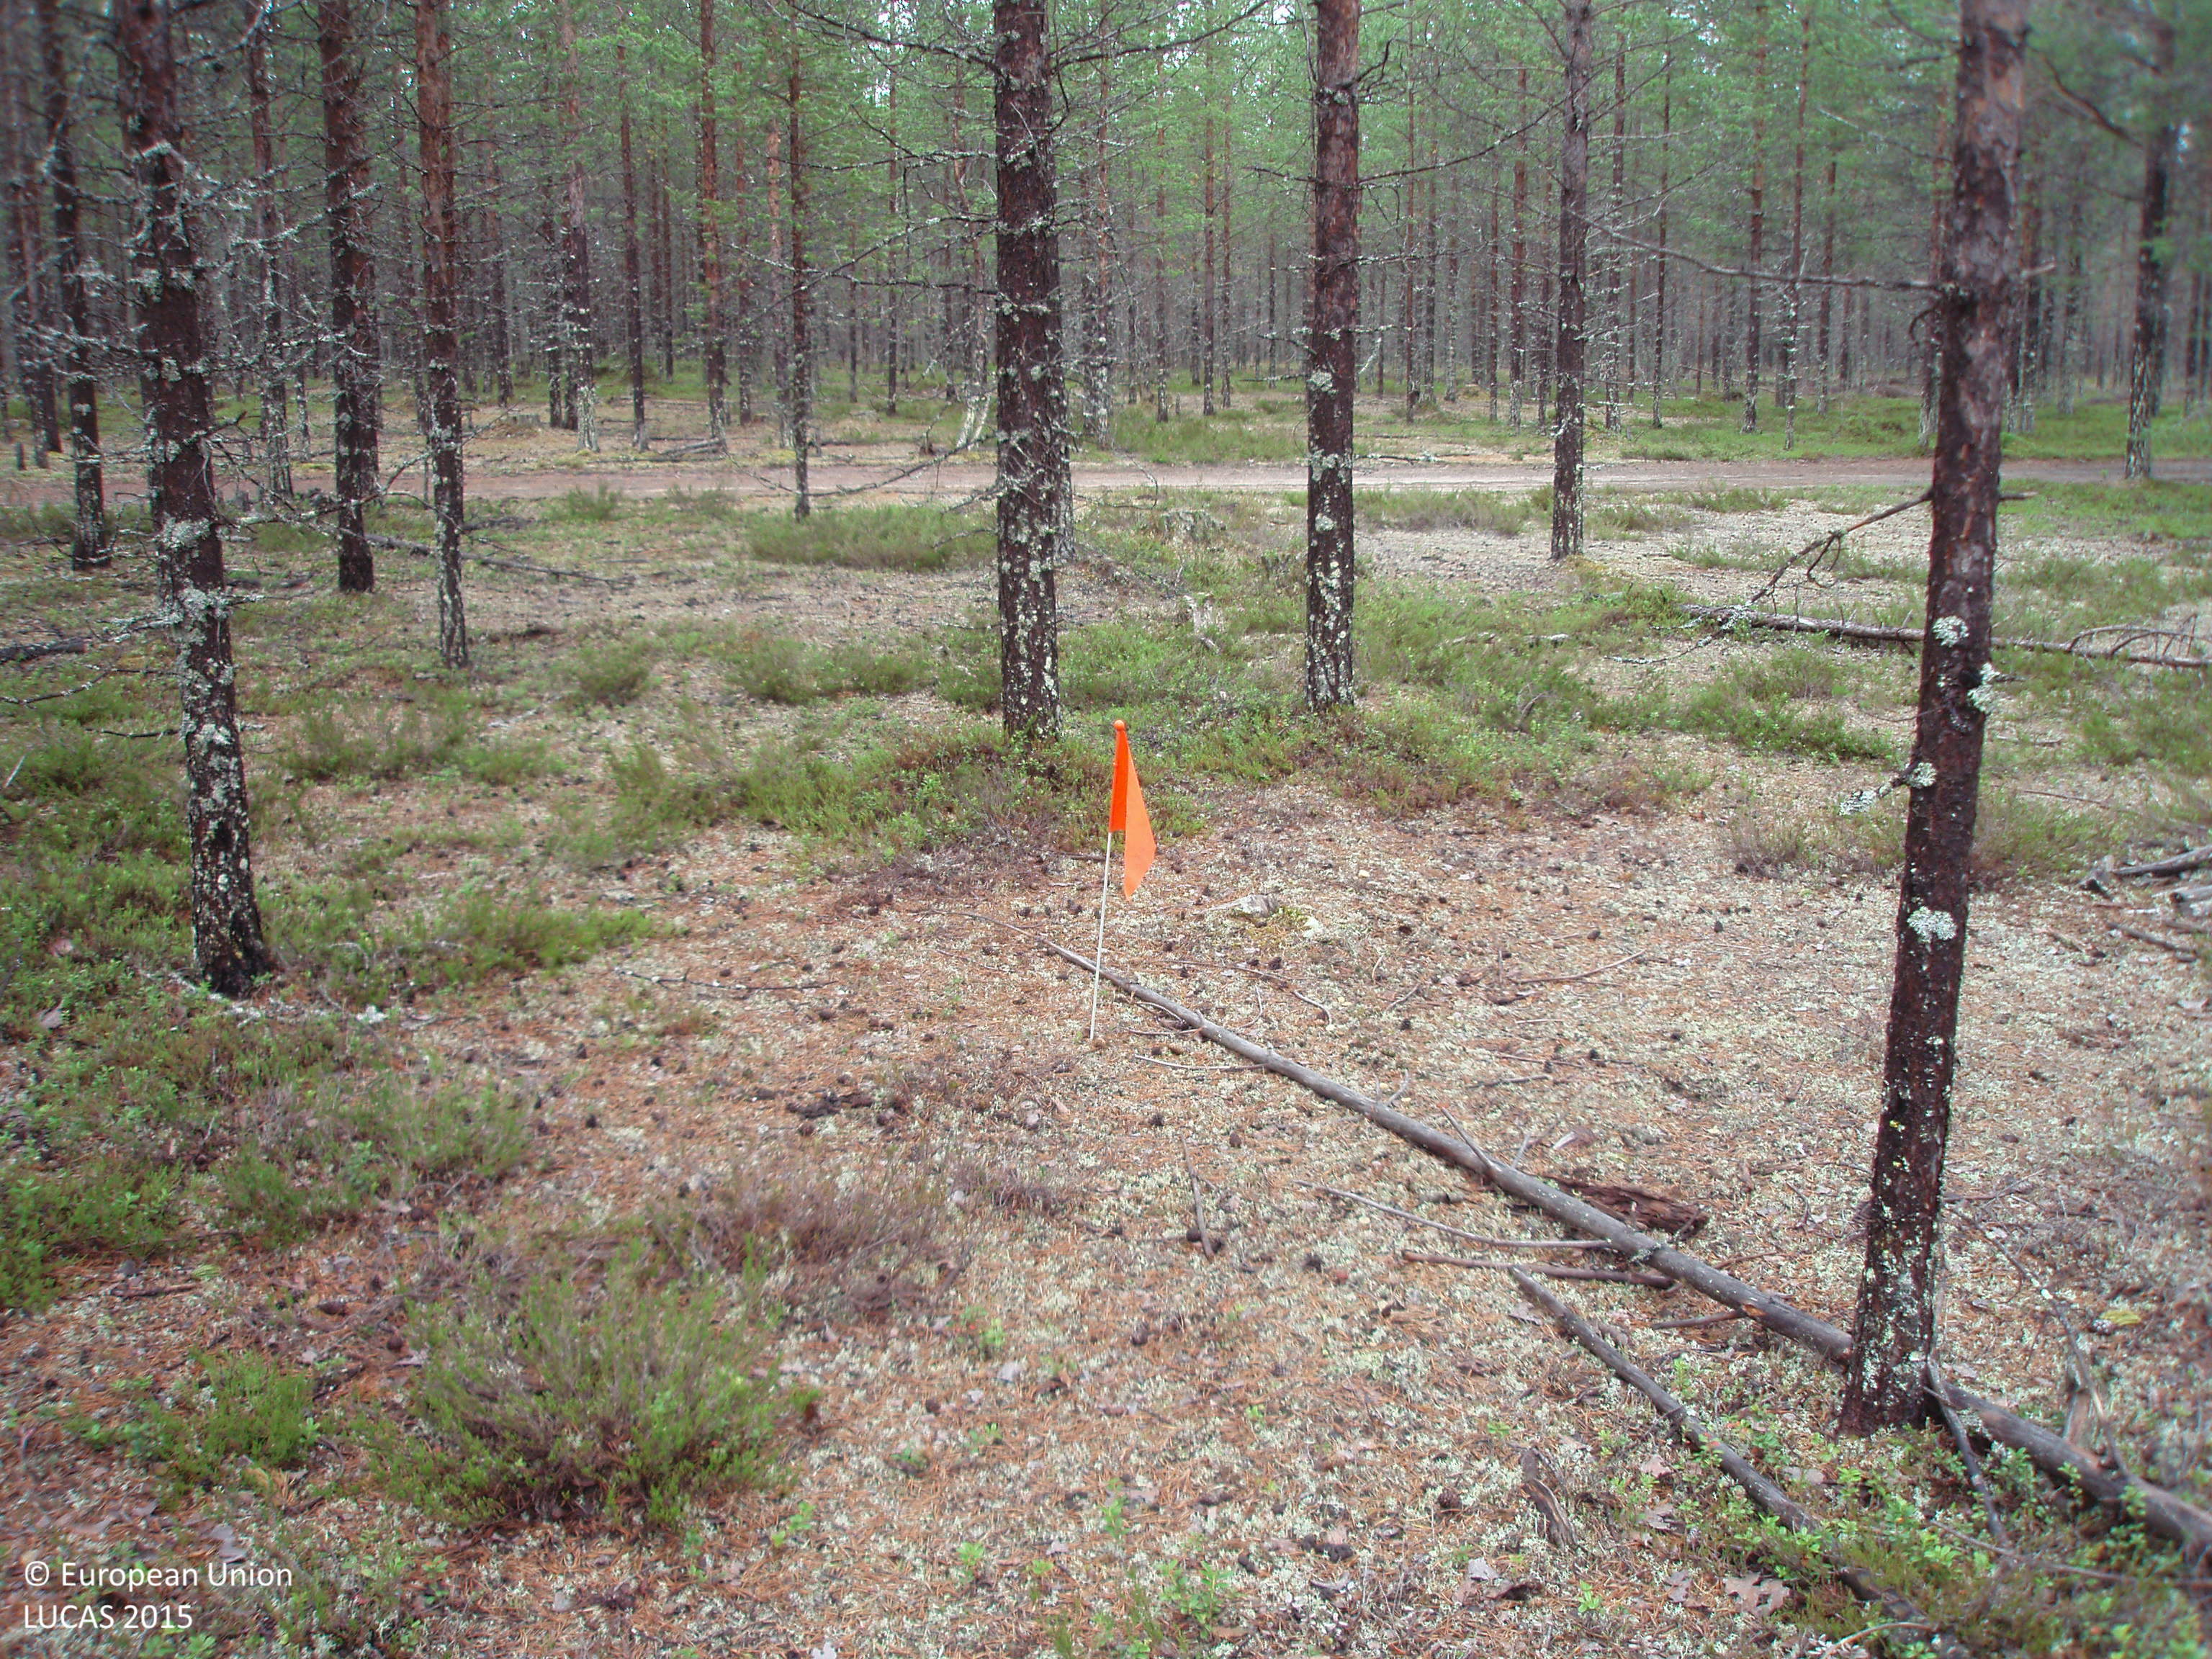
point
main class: Woodland
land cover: Pine dominated coniferous woodland
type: boreal forest
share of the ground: > 75 %
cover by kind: coniferous forest trees 75 %, shrubs 20 %, lichens and mosses 5 %
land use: Forestry
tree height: > 5 m
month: July
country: FI
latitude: 65.9992
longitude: 28.0515
